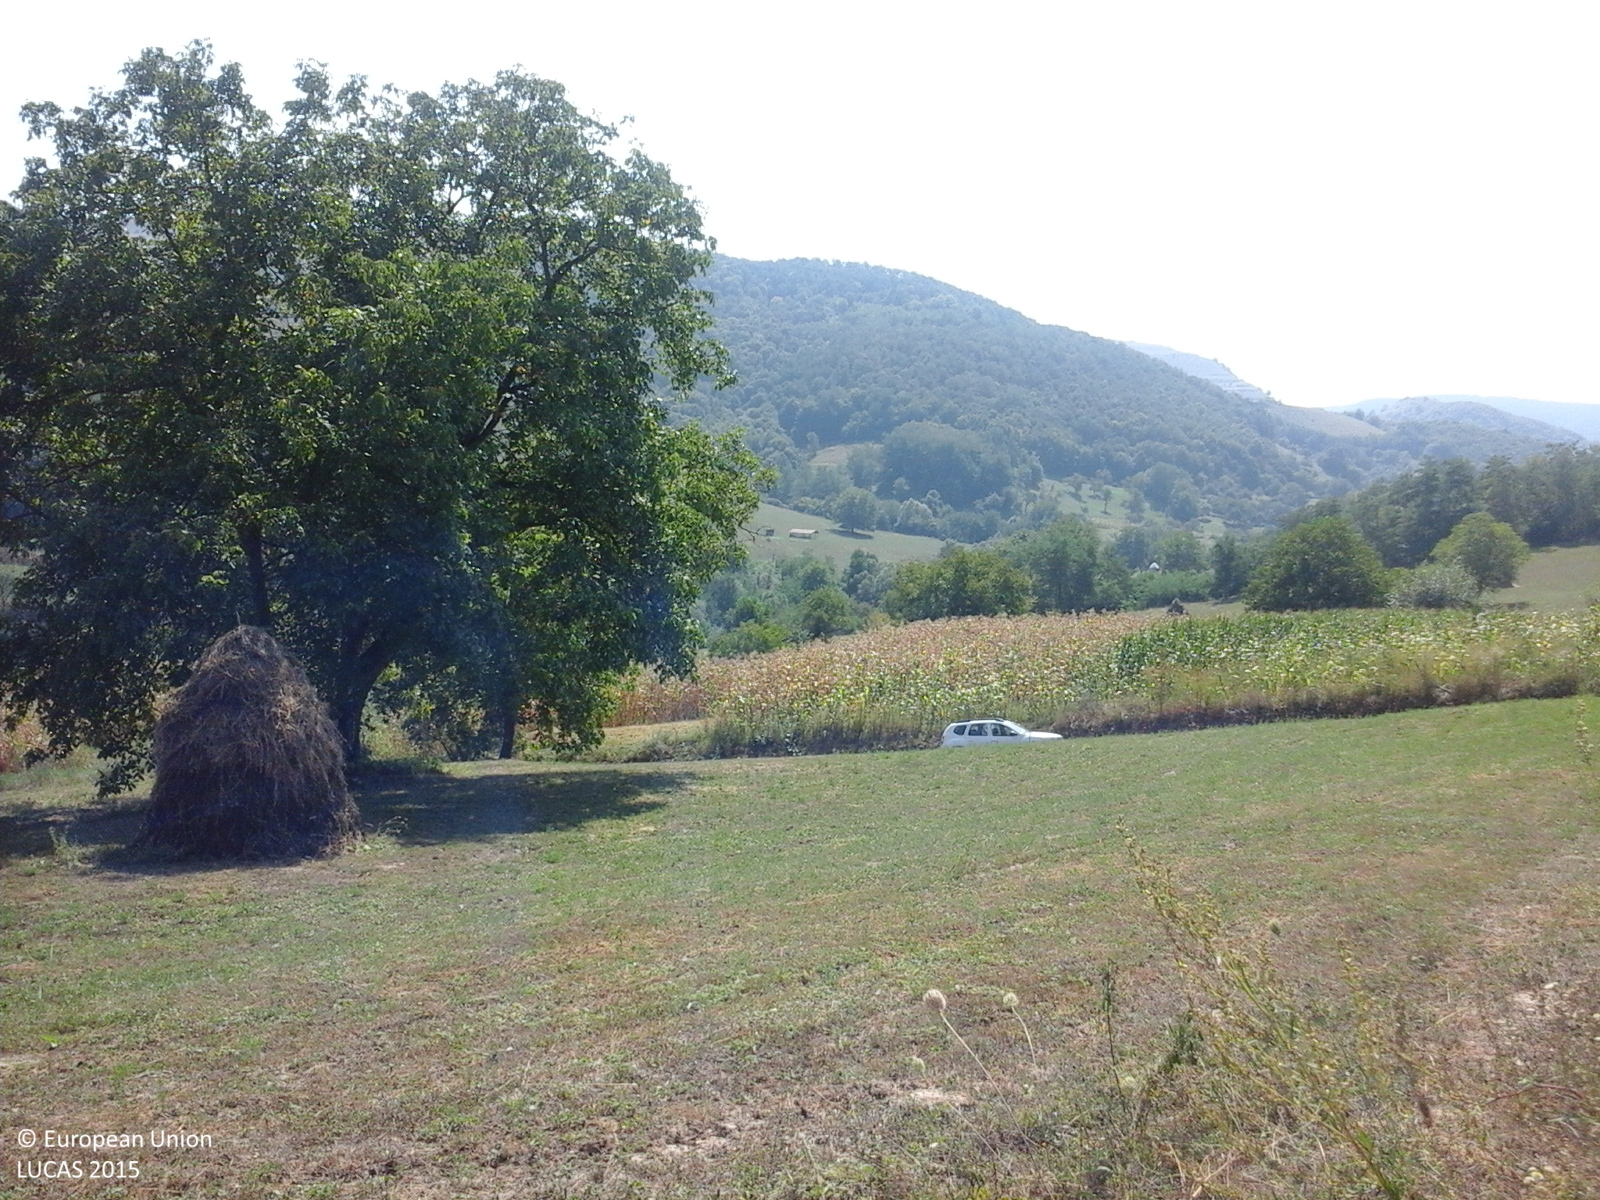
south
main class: Grassland
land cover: Spontaneously vegetated surfaces
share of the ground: > 75 %
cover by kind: herbaceous plants 100 %
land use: Fallow land
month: September
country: RO
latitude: 47.0731
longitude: 24.1078
